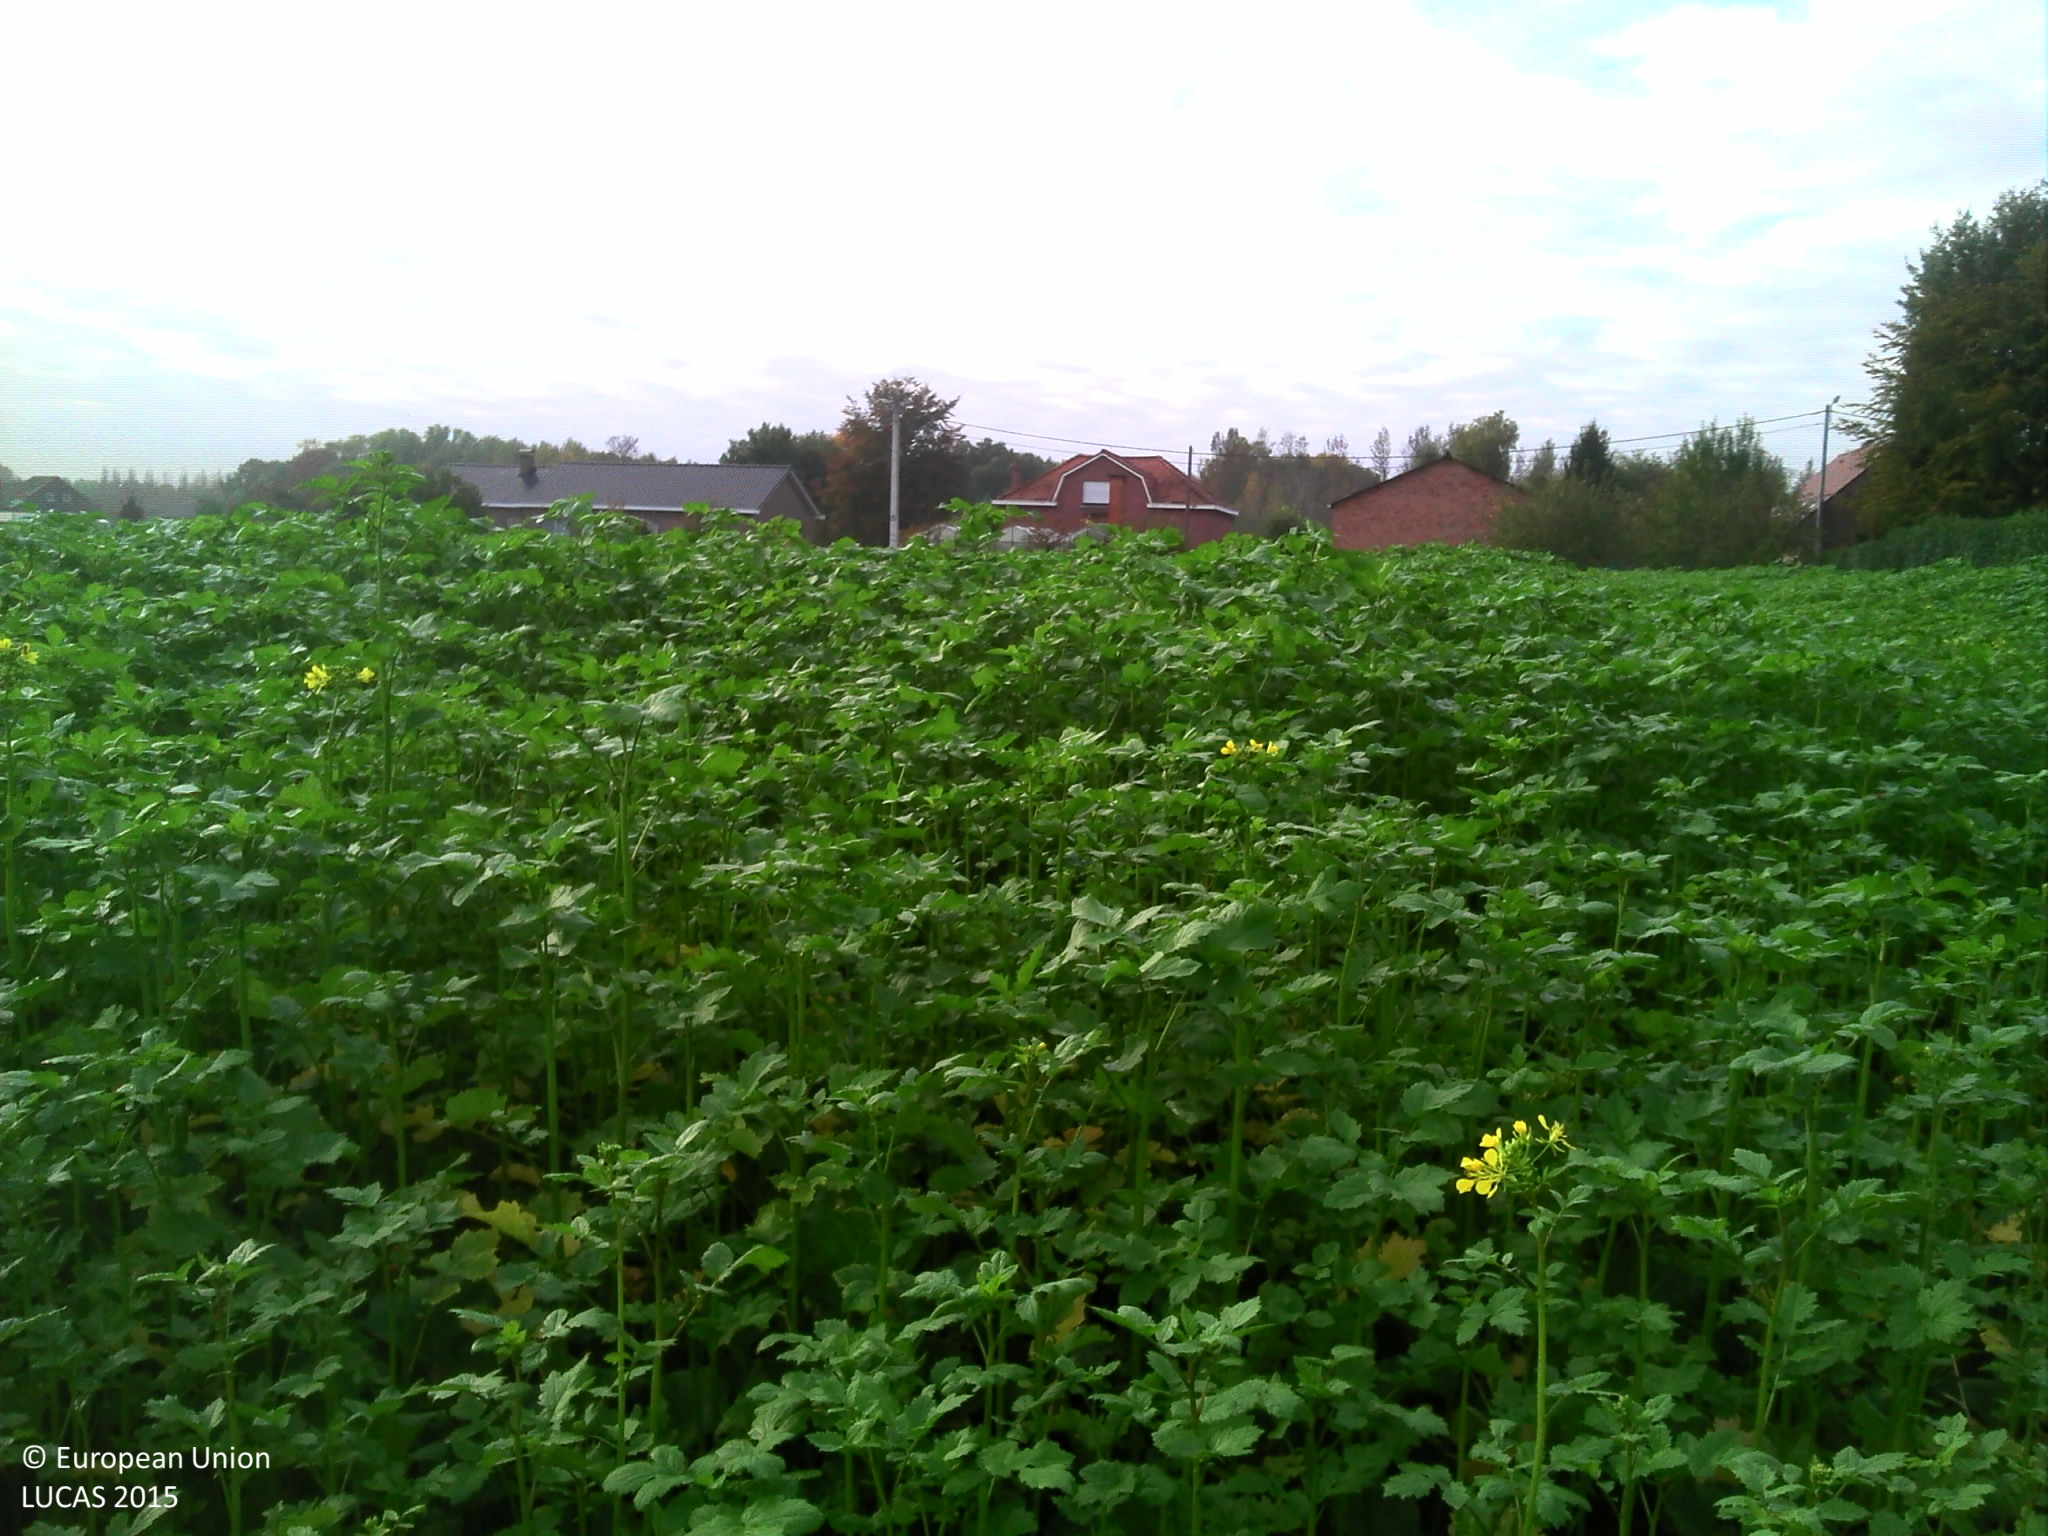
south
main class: Grassland
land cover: Grassland without tree/shrub cover
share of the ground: > 75 %
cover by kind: herbaceous plants 100 %
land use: Residential
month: October
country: BE
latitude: 50.9561
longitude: 4.5720
